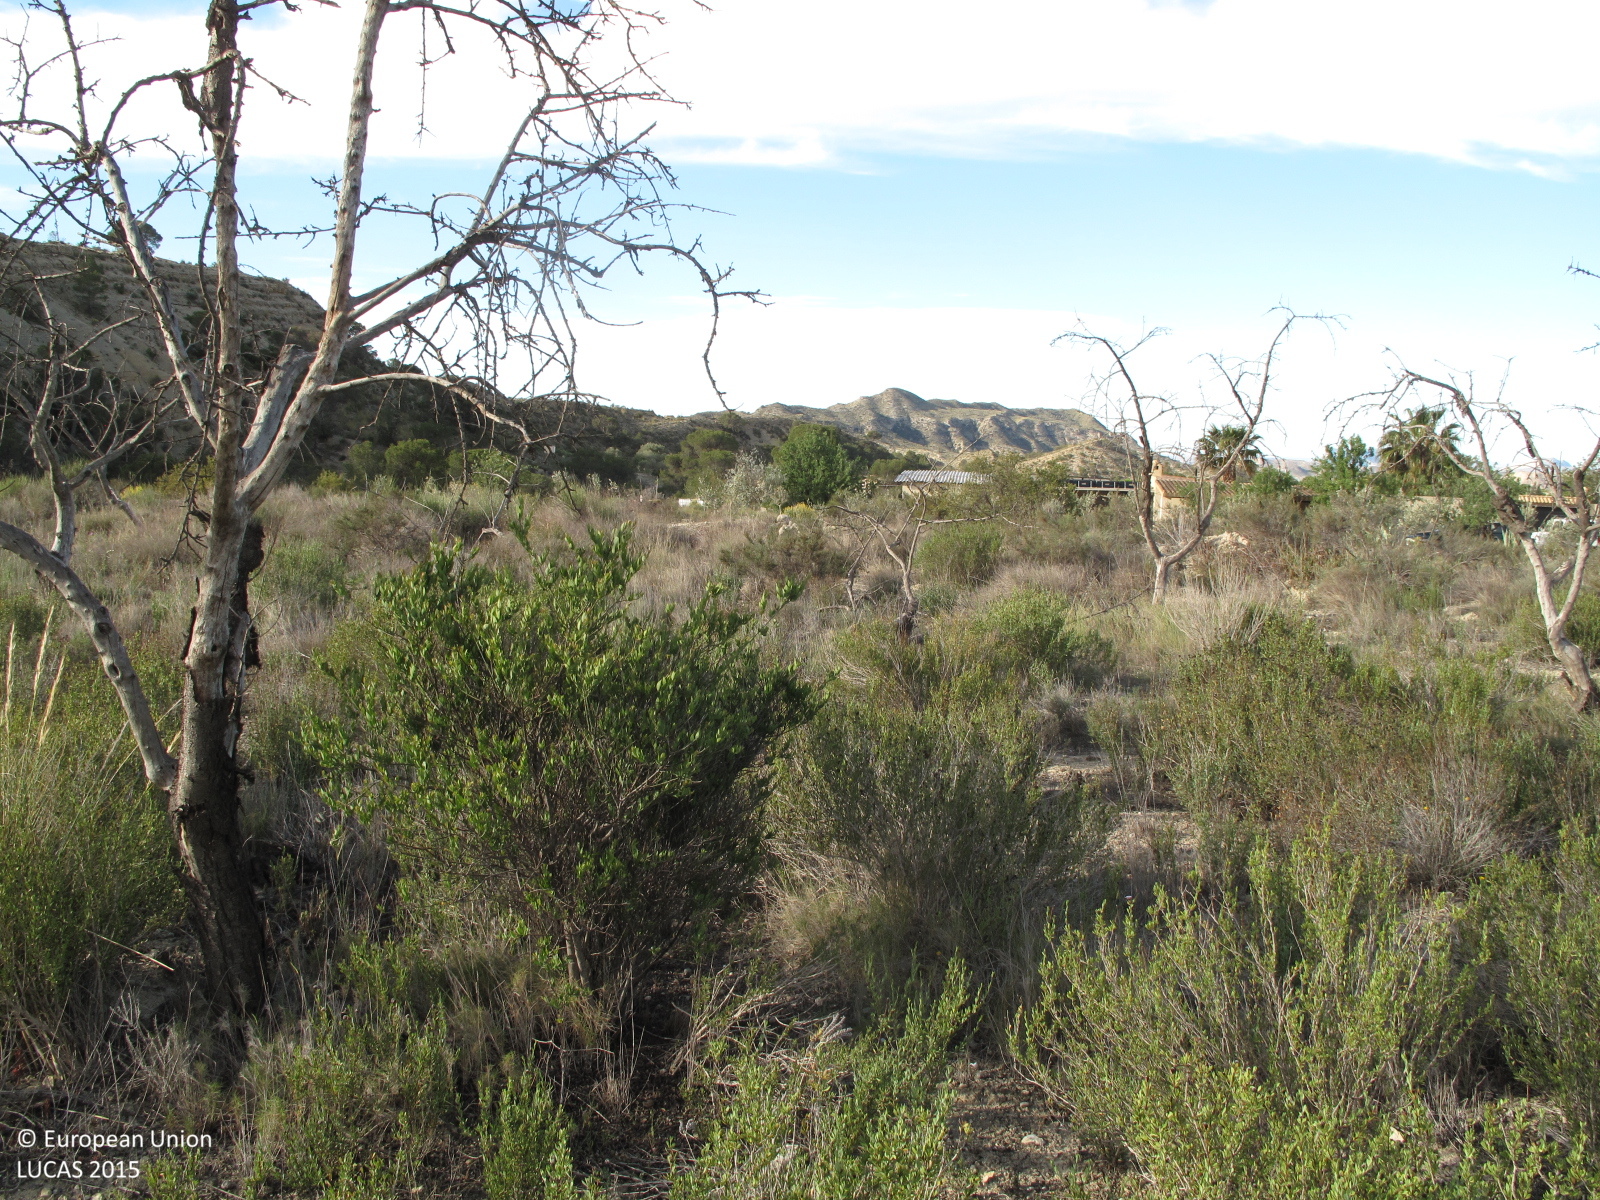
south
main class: Shrubland
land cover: Shrubland with sparse tree cover
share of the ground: 50 - 75 %
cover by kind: shrubs 50 %, consolidated bare surface 35 %, herbaceous plants 10 %, coniferous forest trees 5 %
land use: Abandoned areas
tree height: < 5 m
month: April
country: ES
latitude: 38.5209
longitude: -0.4591
